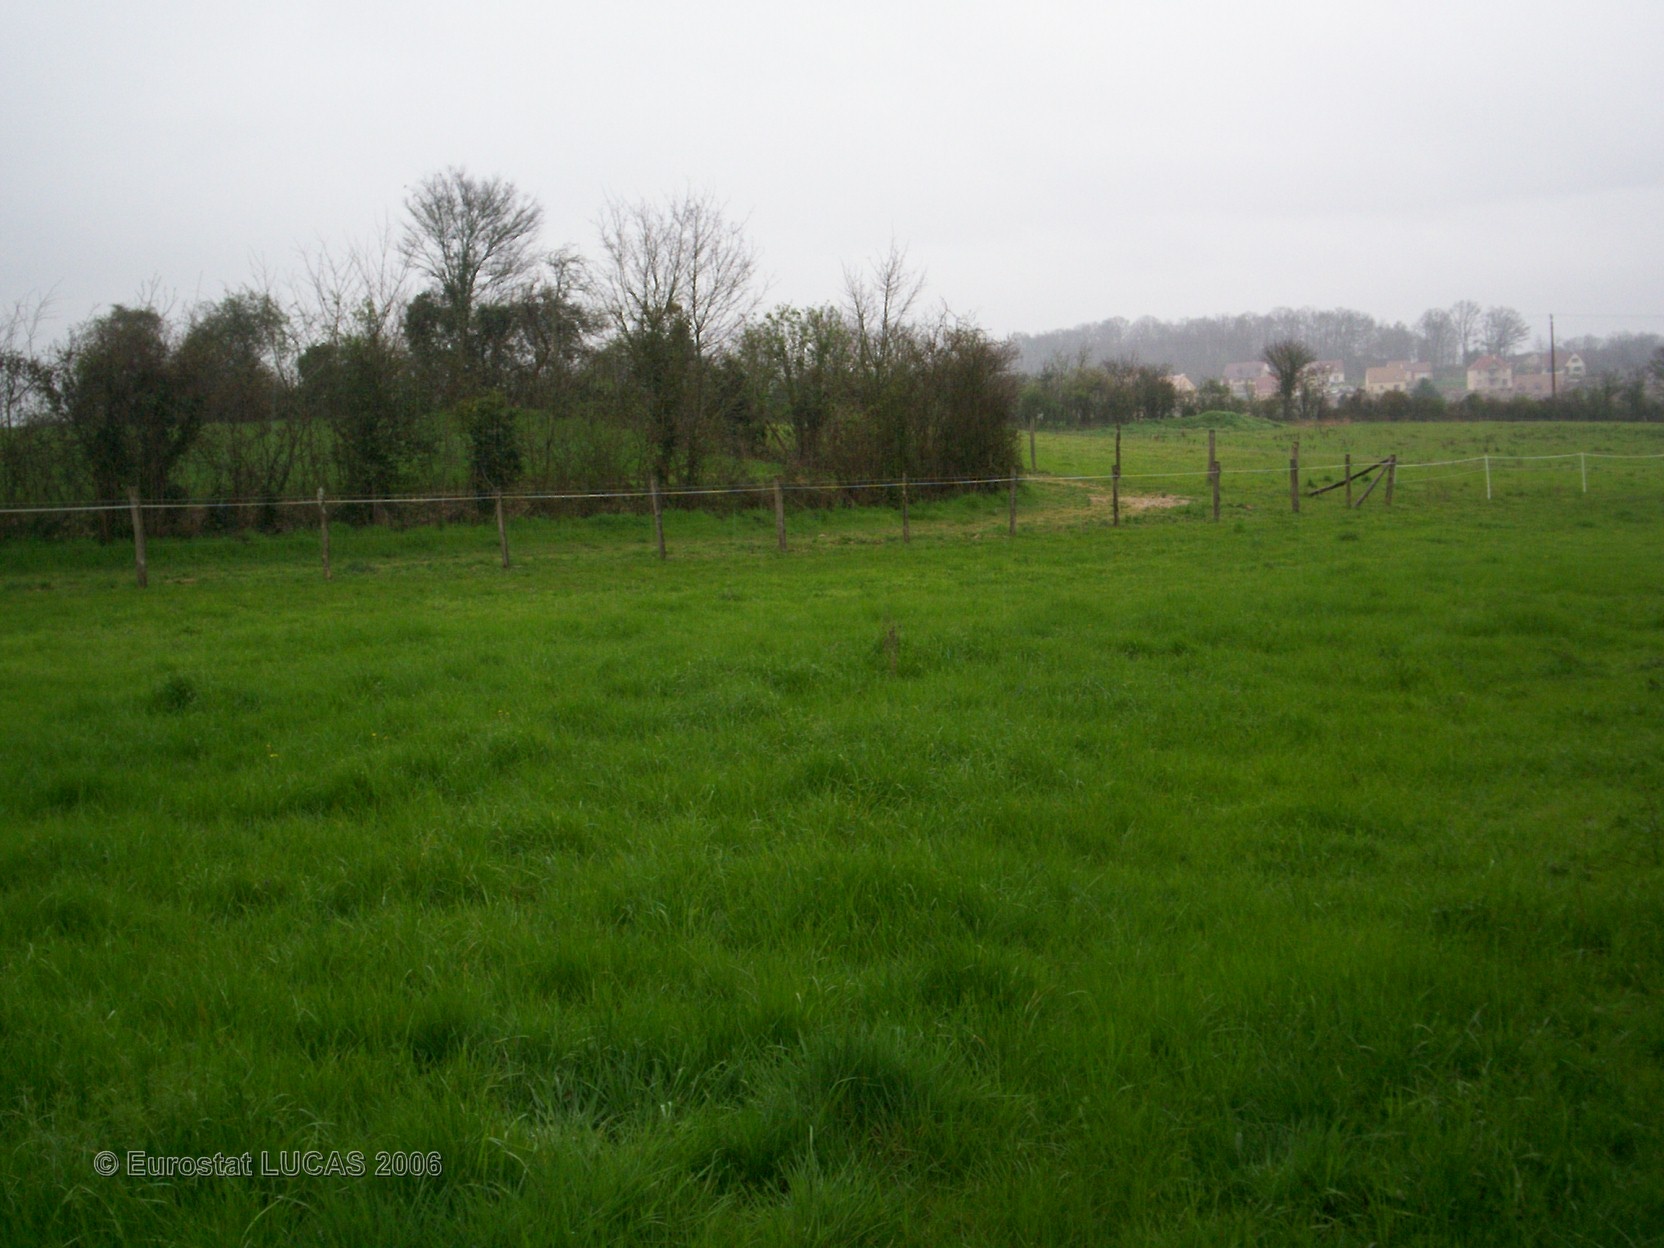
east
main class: Grassland
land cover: Grassland without tree/shrub cover
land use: Agriculture (excluding fallow land and kitchen gardens)
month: April
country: FR
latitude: 48.3575
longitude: 0.1064
